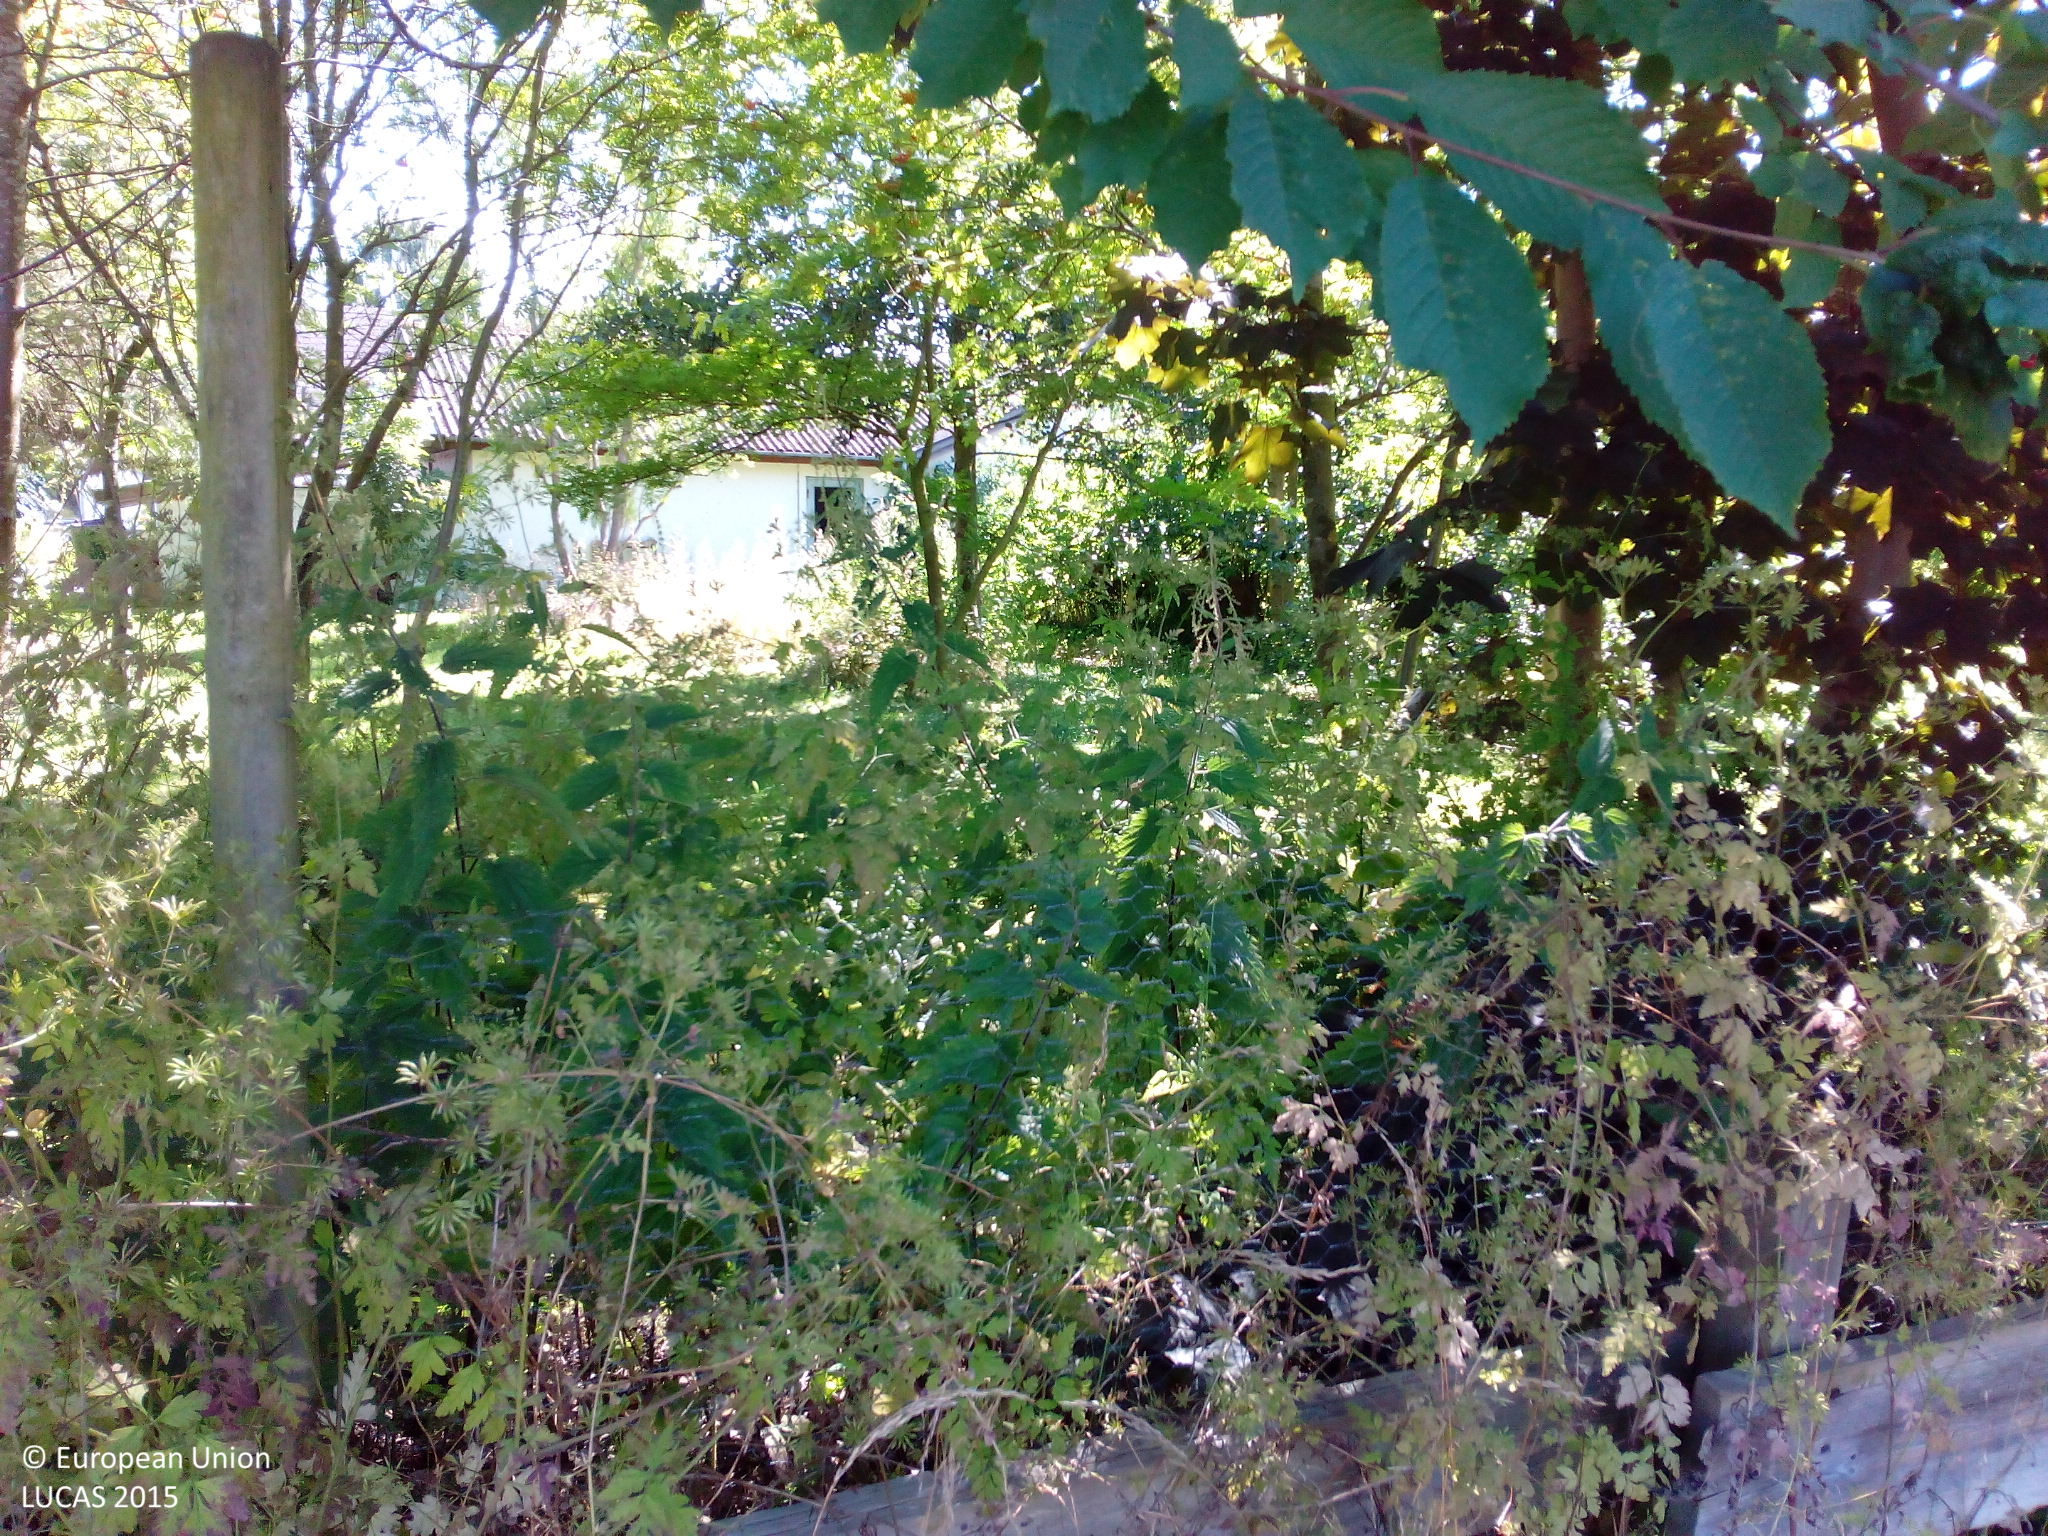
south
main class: Woodland
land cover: Broadleaved woodland
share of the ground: 50 - 75 %
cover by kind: broadleaved forest trees 65 %, herbaceous plants 35 %
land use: Residential
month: August
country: DK
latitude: 55.6183
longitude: 11.7609
